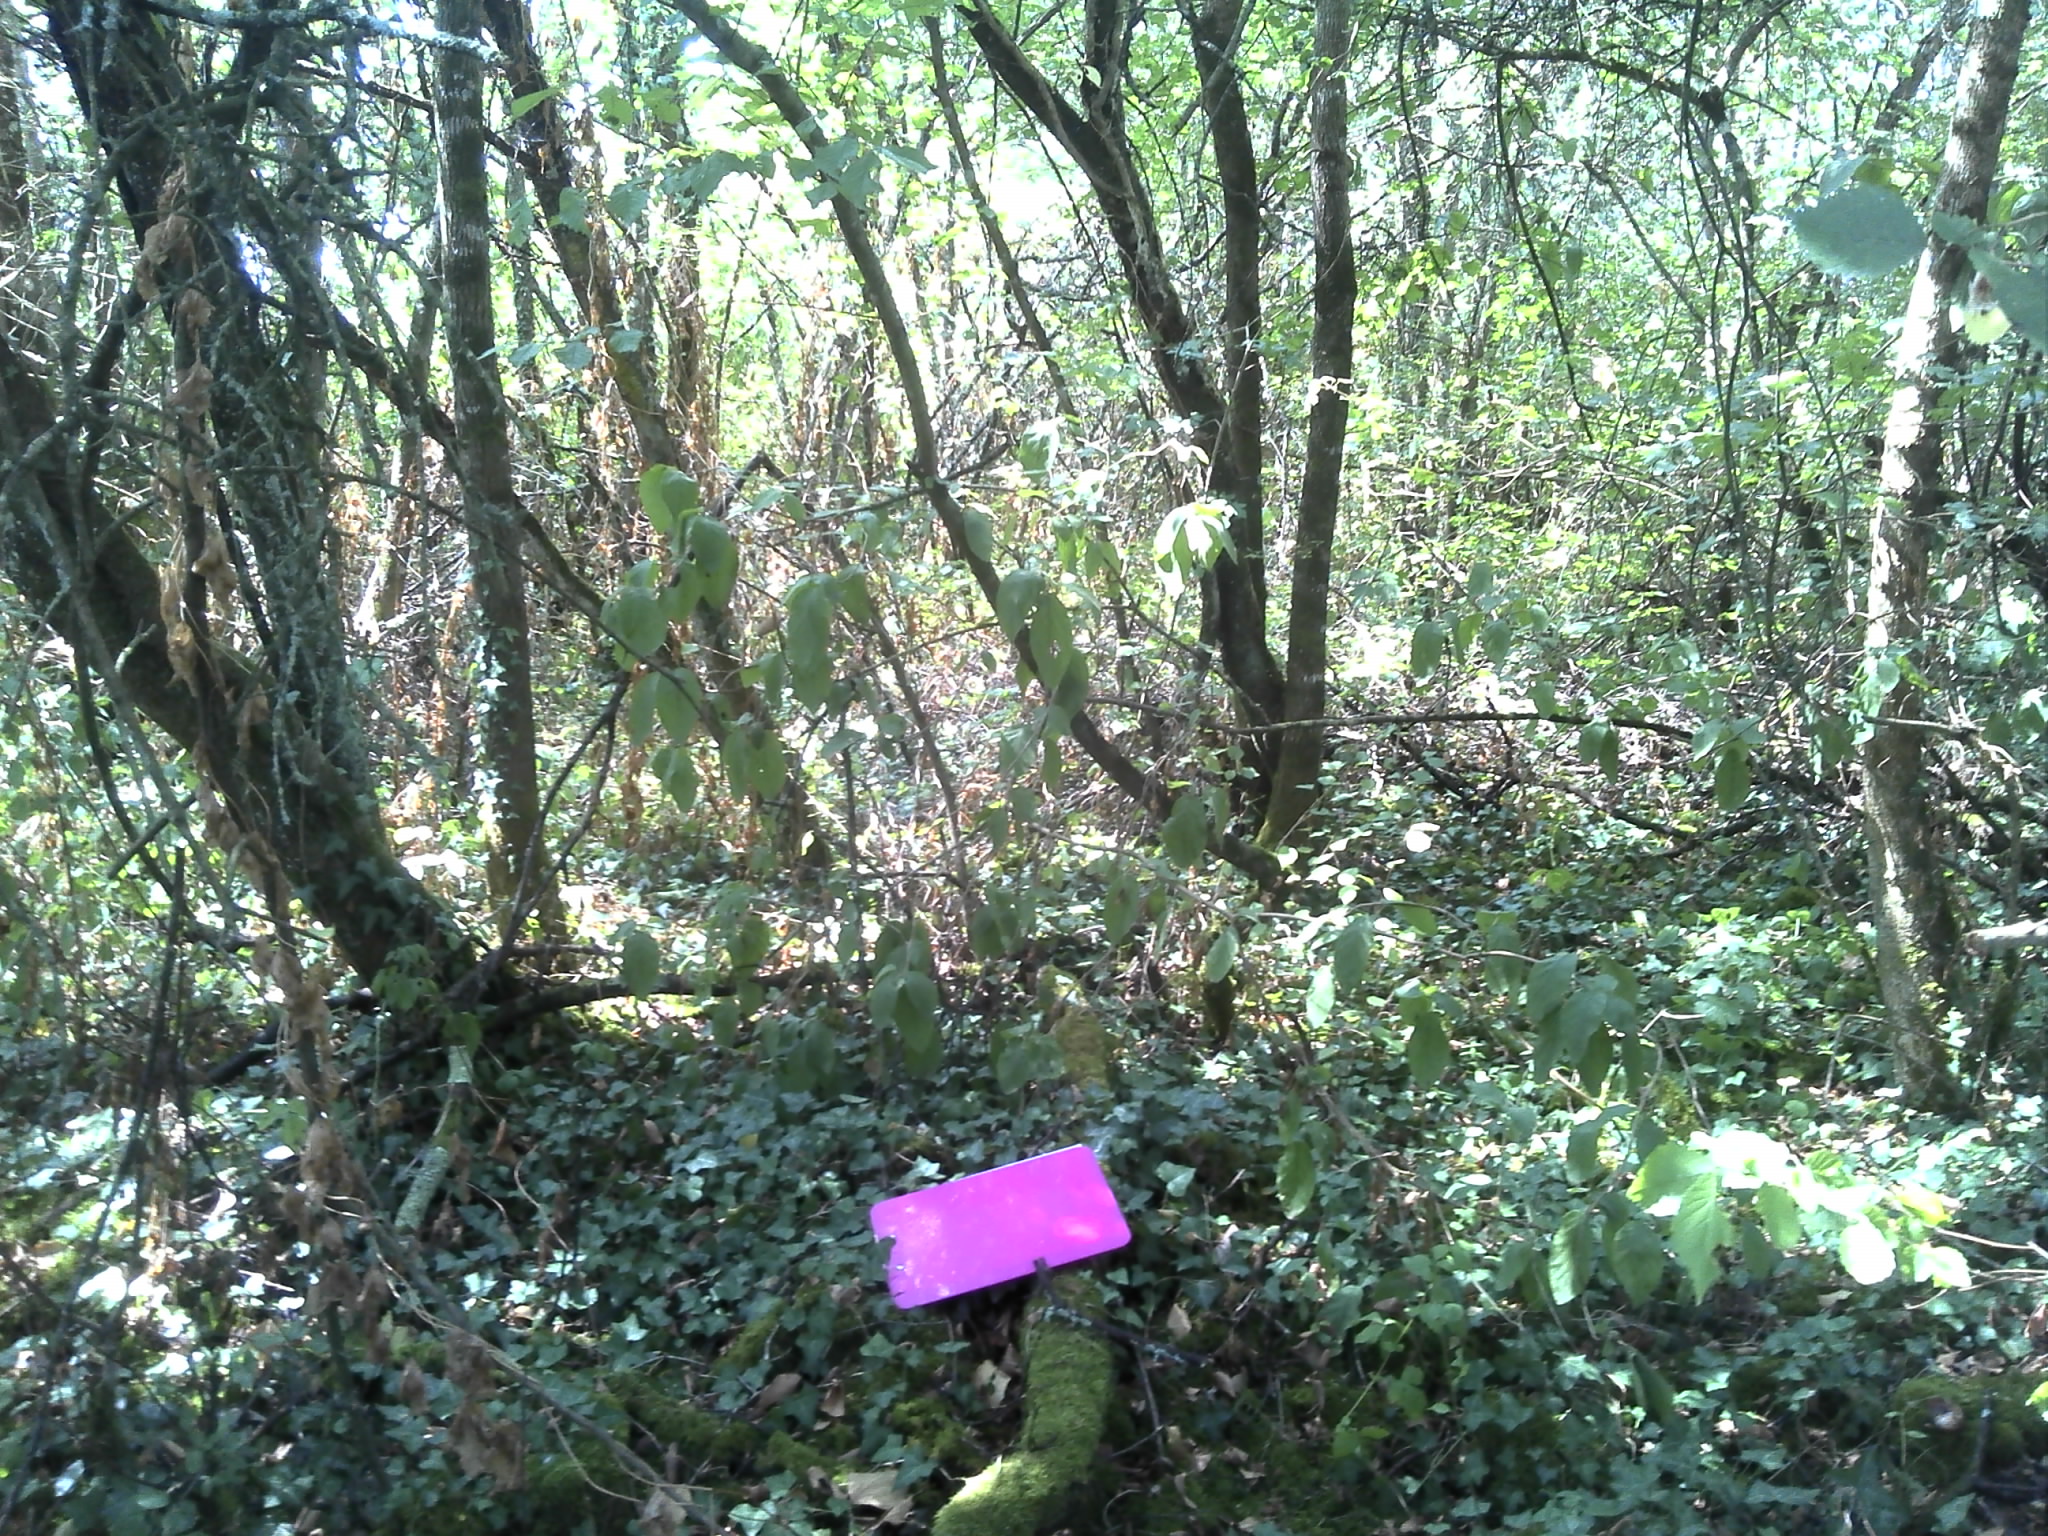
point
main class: Woodland
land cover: Broadleaved woodland
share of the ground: > 75 %
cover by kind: broadleaved forest trees 80 %, shrubs 15 %, herbaceous plants 5 %
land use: Semi-natural and natural areas not in use
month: August
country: FR
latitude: 46.5339
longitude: 1.6853
